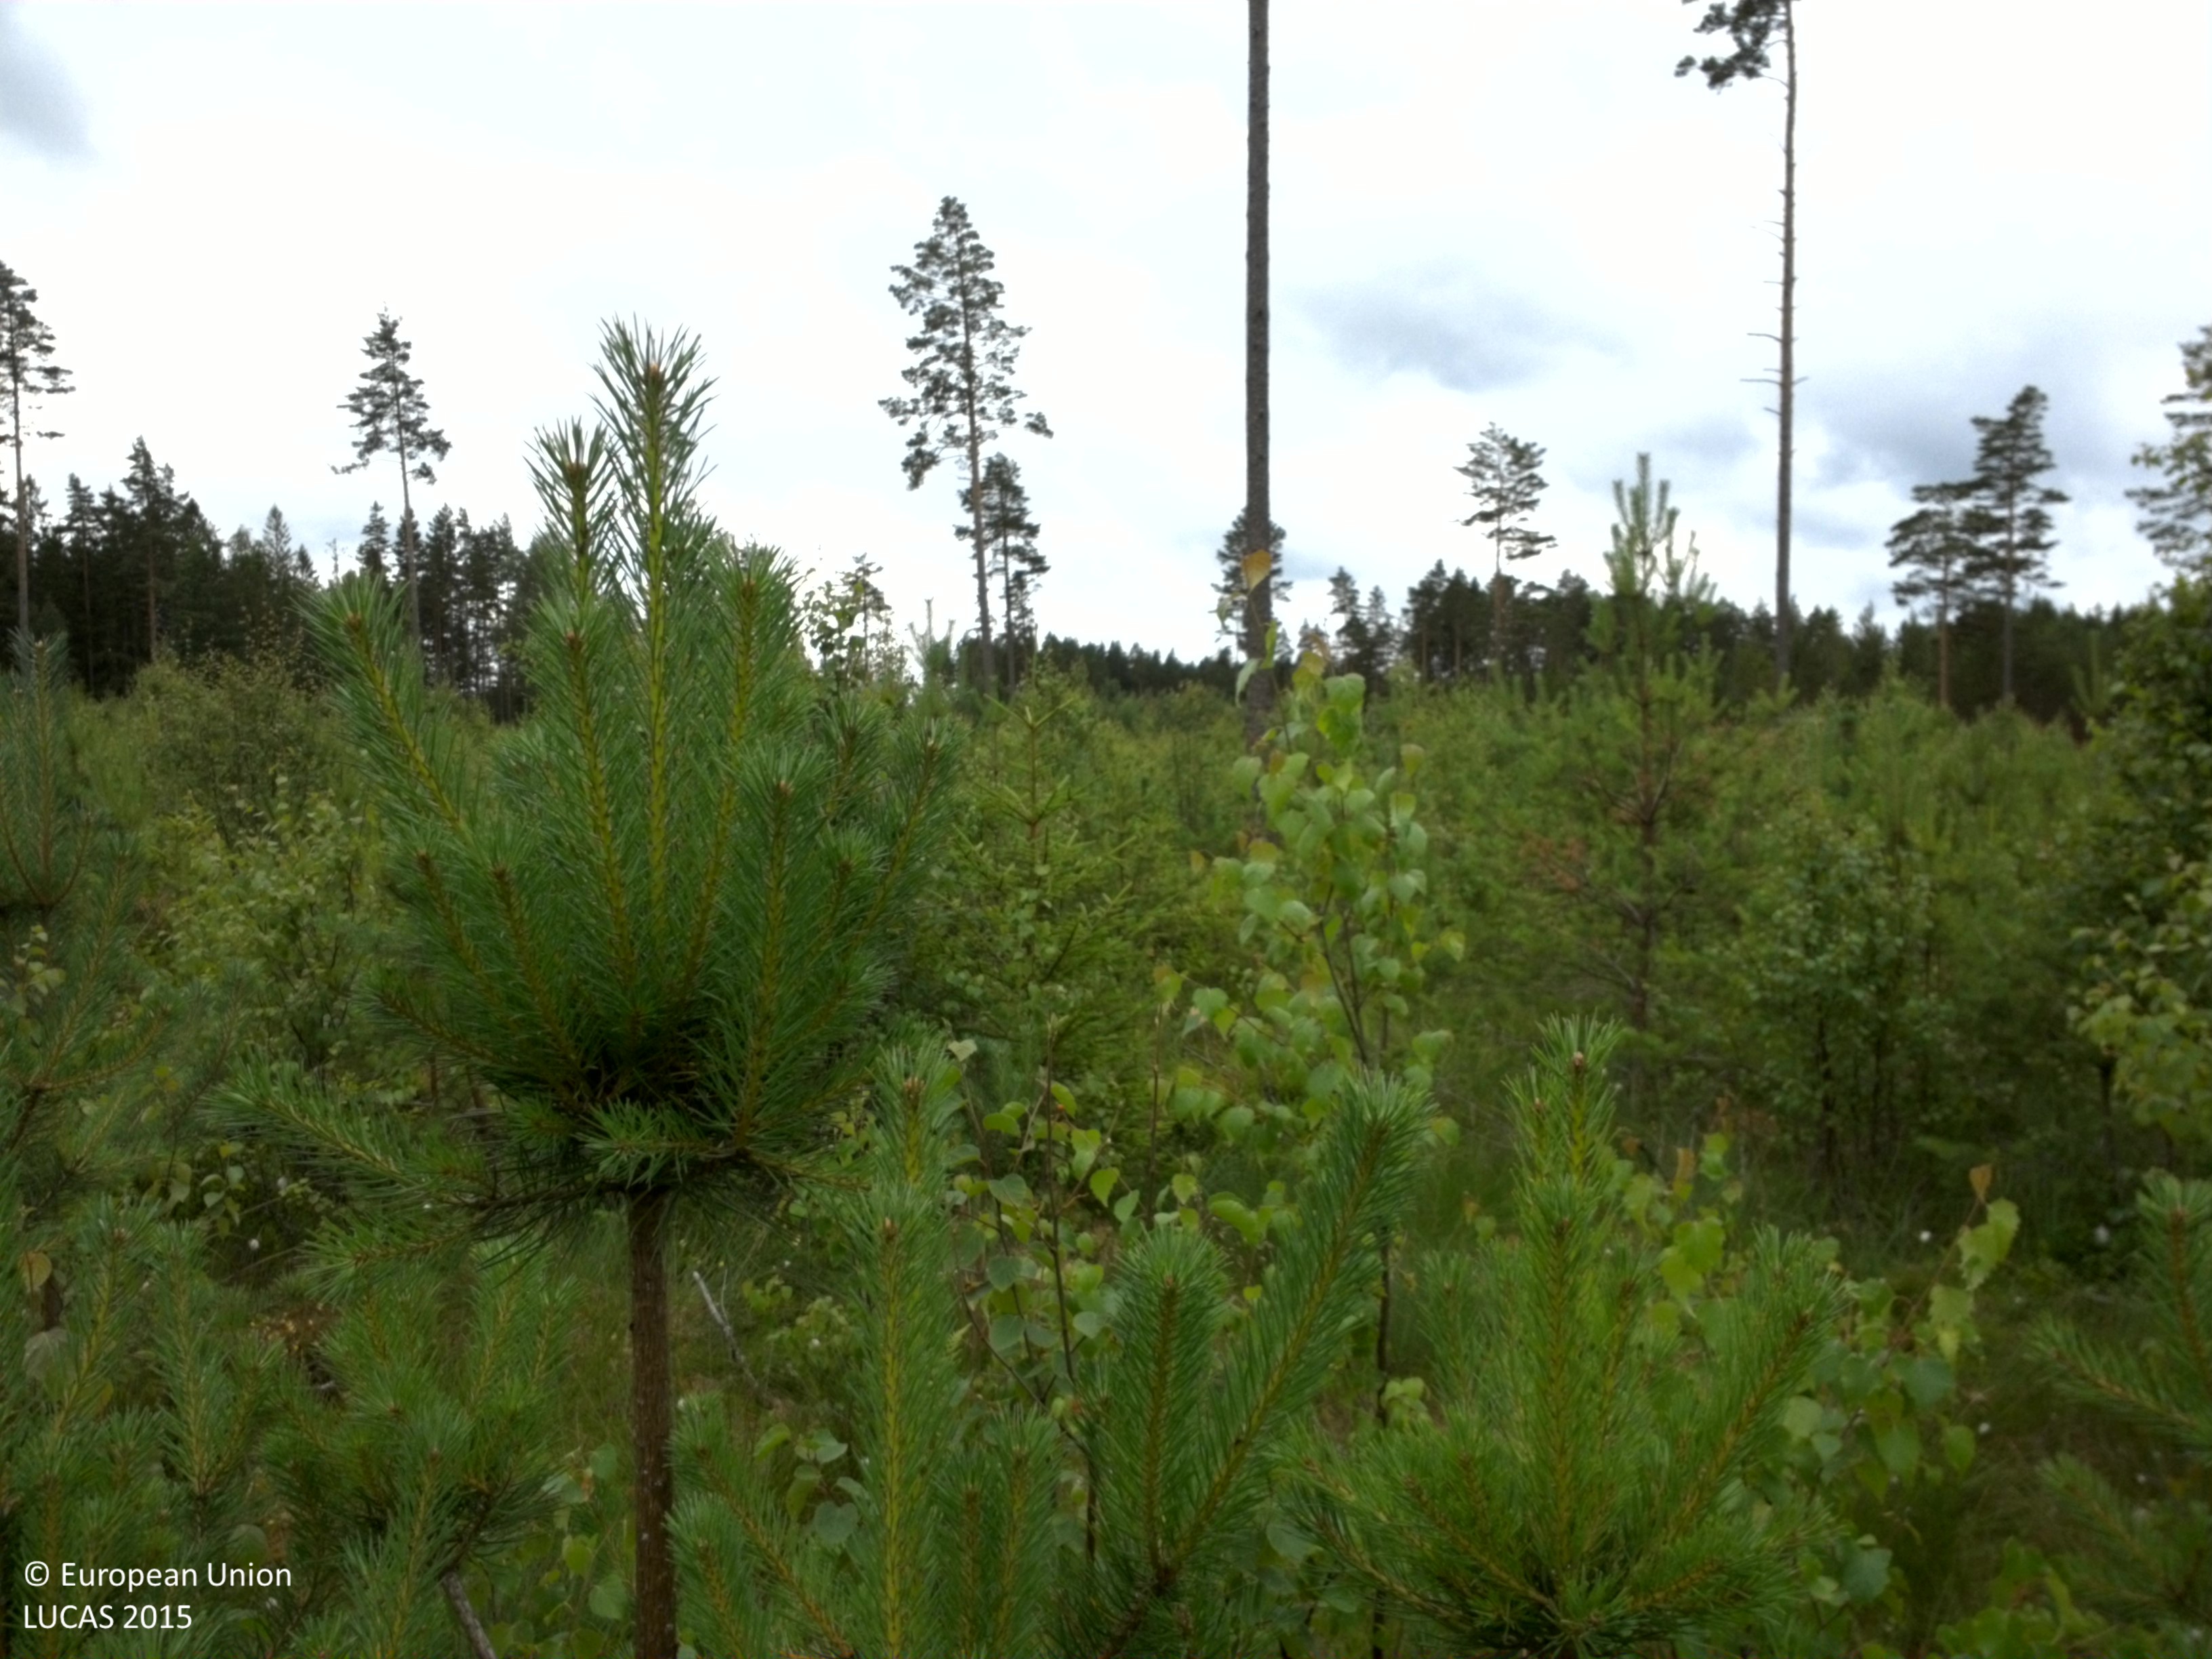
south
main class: Woodland
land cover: Pine dominated mixed woodland
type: boreal forest
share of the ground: 50 - 75 %
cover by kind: coniferous forest trees 45 %, broadleaved forest trees 25 %, herbaceous plants 25 %, shrubs 5 %
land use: Forestry
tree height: > 5 m
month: July
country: SE
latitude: 58.9542
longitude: 14.5297
